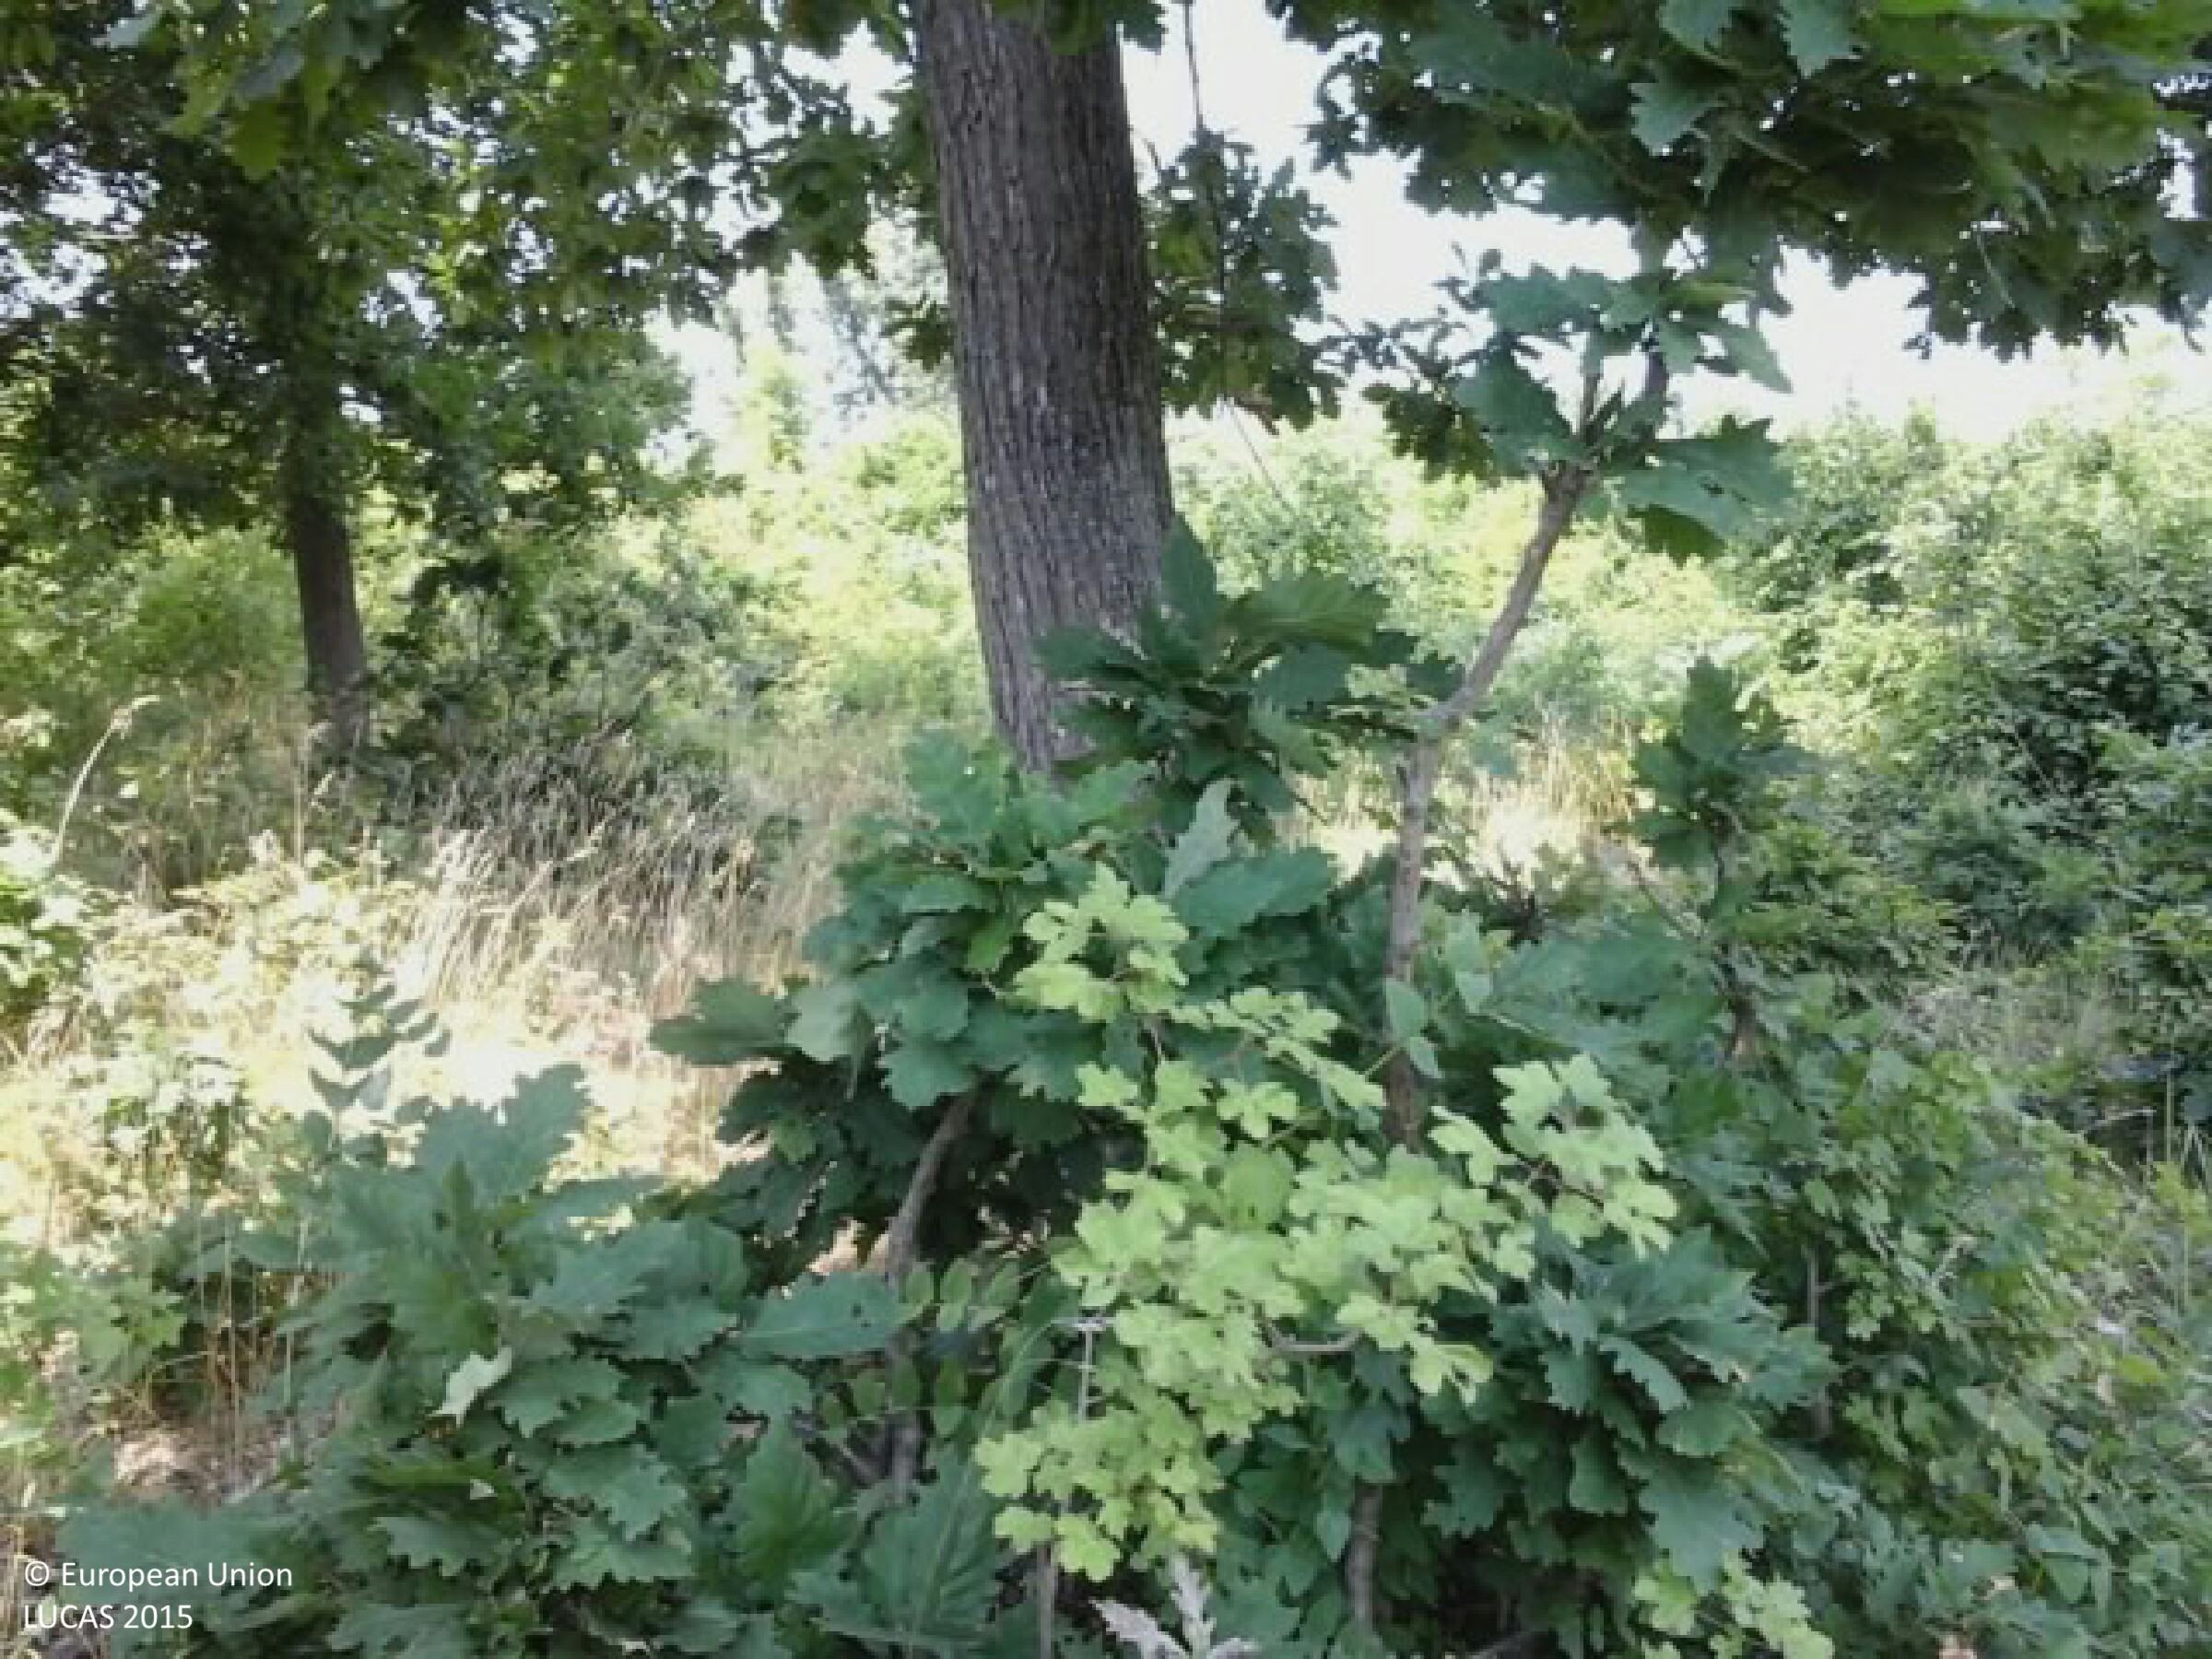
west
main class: Woodland
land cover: Broadleaved woodland
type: mesophytic deciduous forest
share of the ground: > 75 %
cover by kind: broadleaved forest trees 100 %
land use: Forestry
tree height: < 5 m
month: July
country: HU
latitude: 47.7355
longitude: 19.3420
